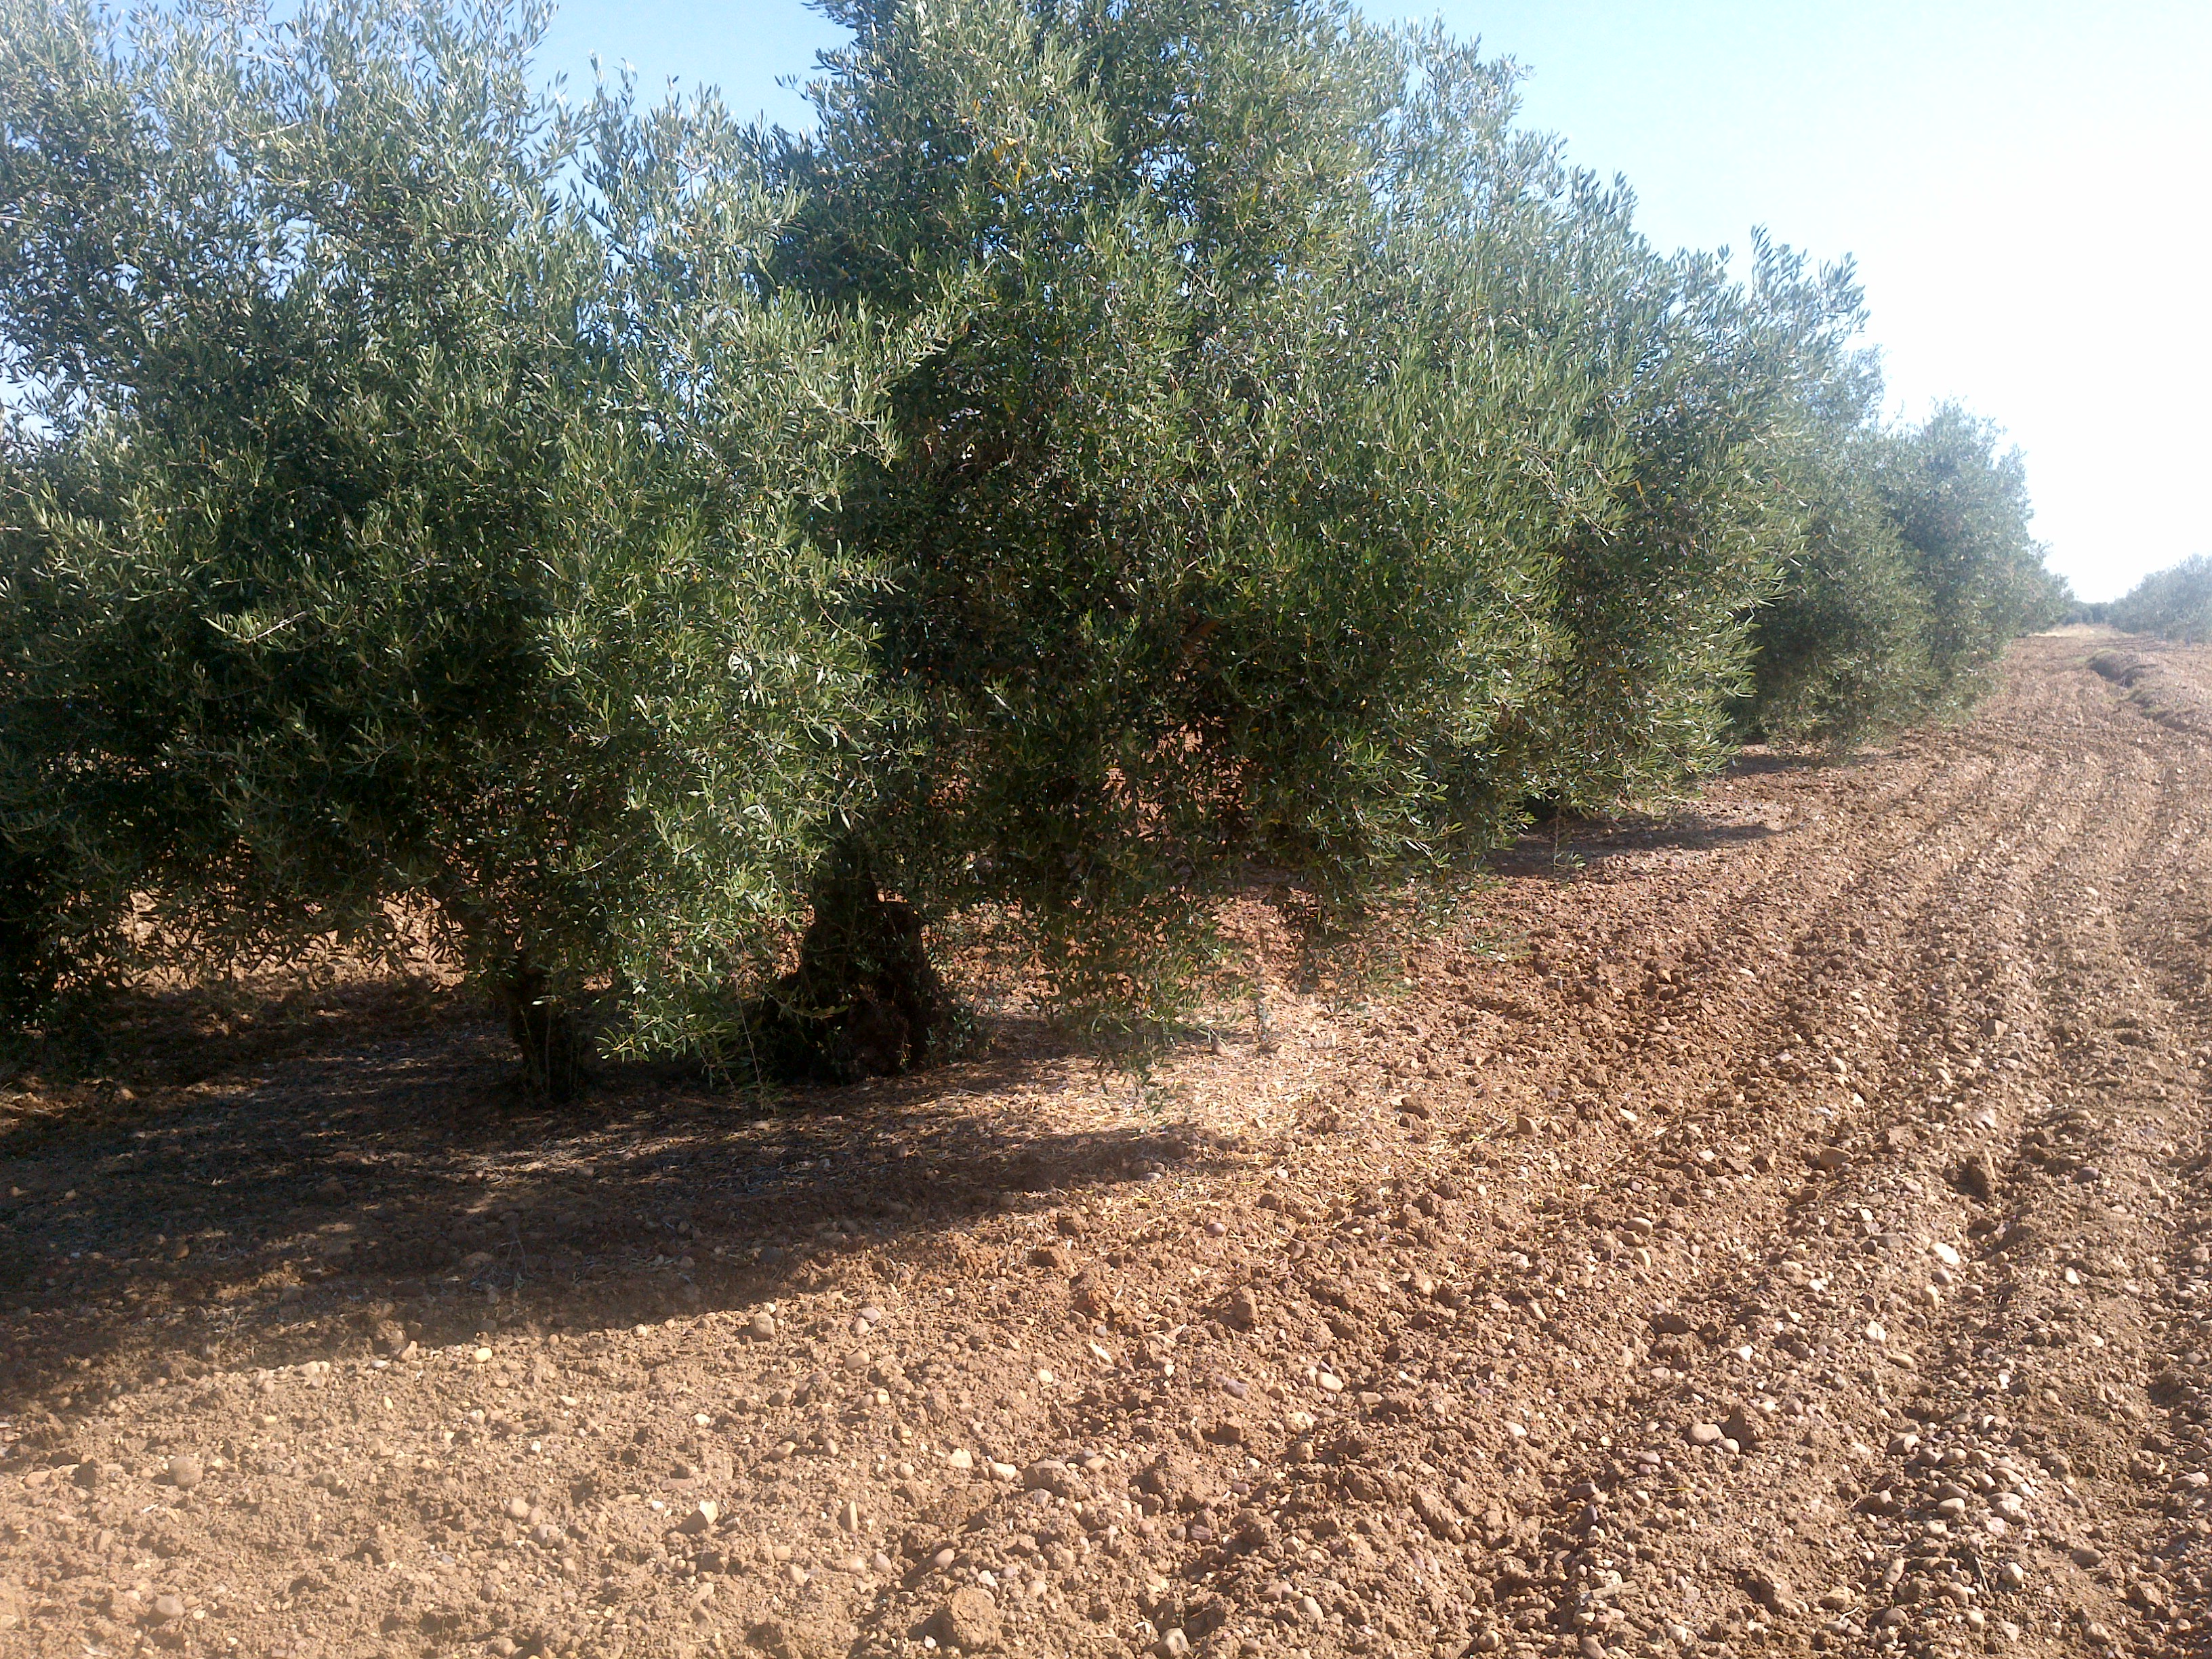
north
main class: Cropland
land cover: Olive groves
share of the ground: 25 - 50 %
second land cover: Other bare soil
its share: > 75 %
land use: Agriculture (excluding fallow land and kitchen gardens)
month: June
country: ES
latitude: 37.7170
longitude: -4.9546
